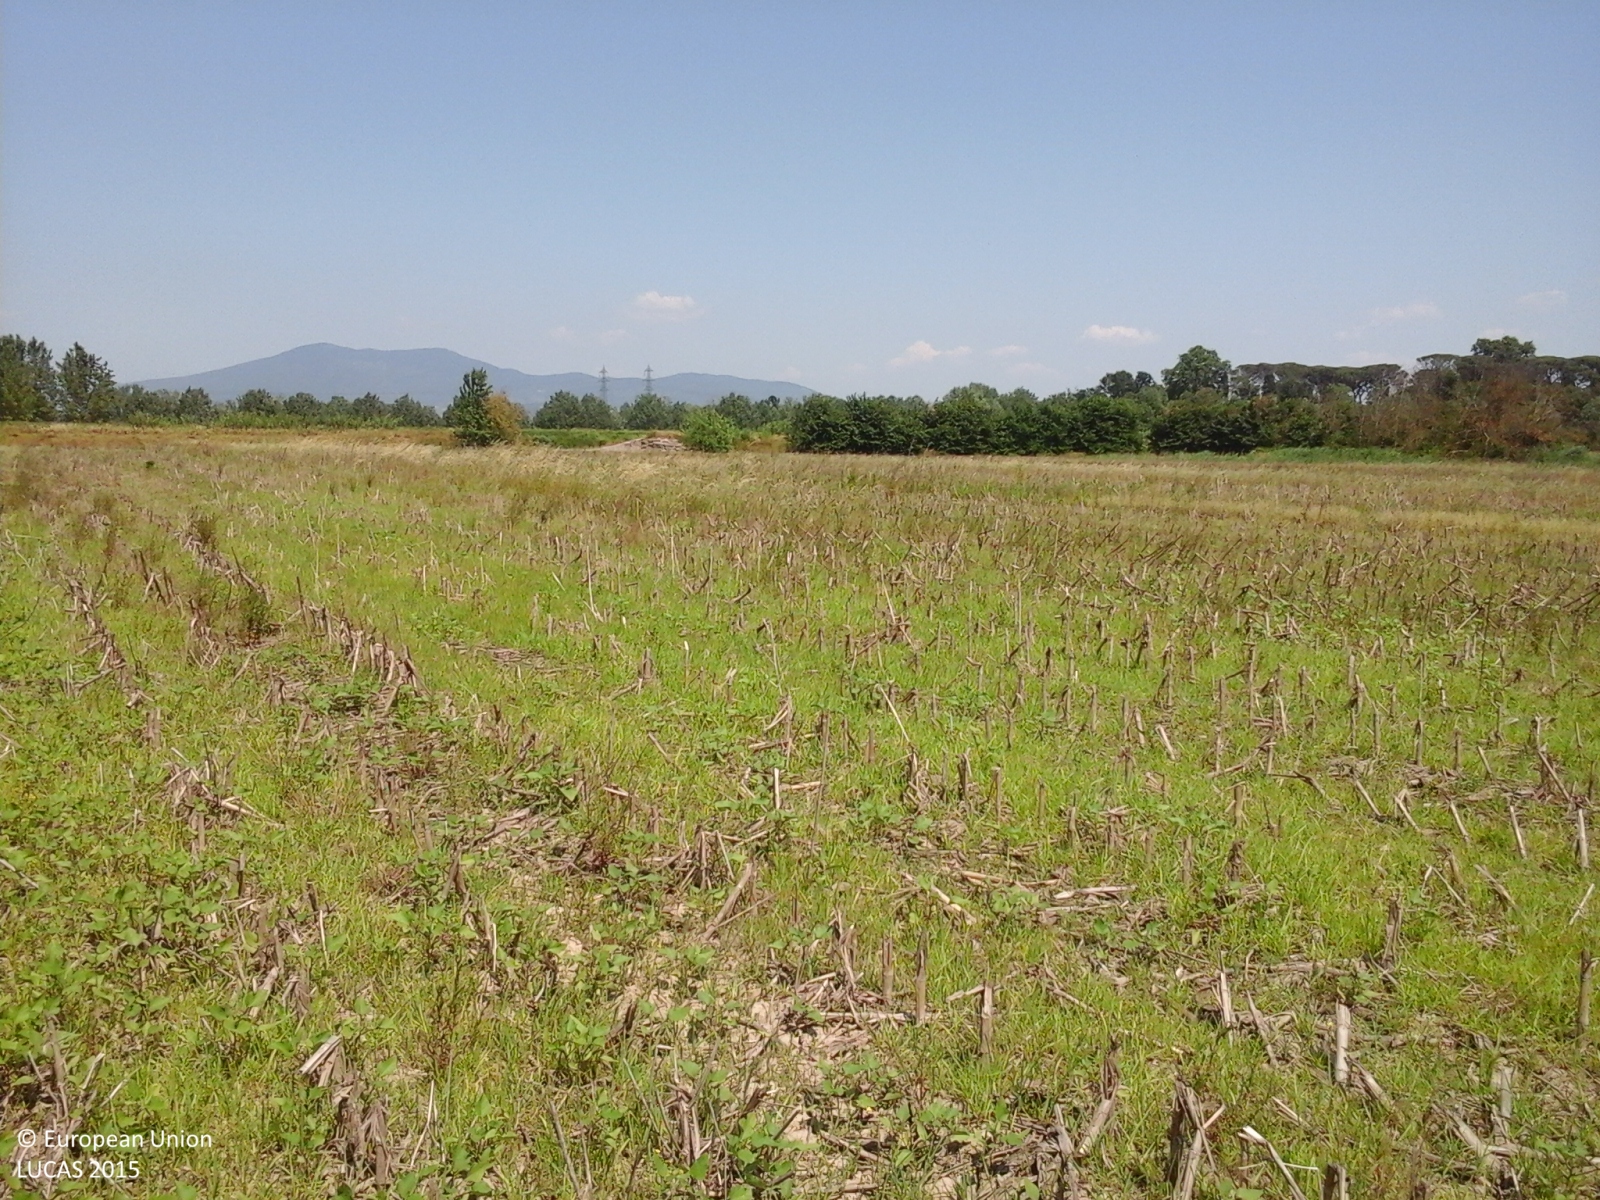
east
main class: Grassland
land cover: Spontaneously vegetated surfaces
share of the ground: > 75 %
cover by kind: herbaceous plants 100 %
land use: Agriculture (excluding fallow land and kitchen gardens)
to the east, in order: Spontaneously vegetated surfaces; Shrubland with sparse tree cover; Grass margins; Tracks; Grass margins; Ditches and canals; Grass margins
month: June
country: IT
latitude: 43.8220
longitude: 11.0541
